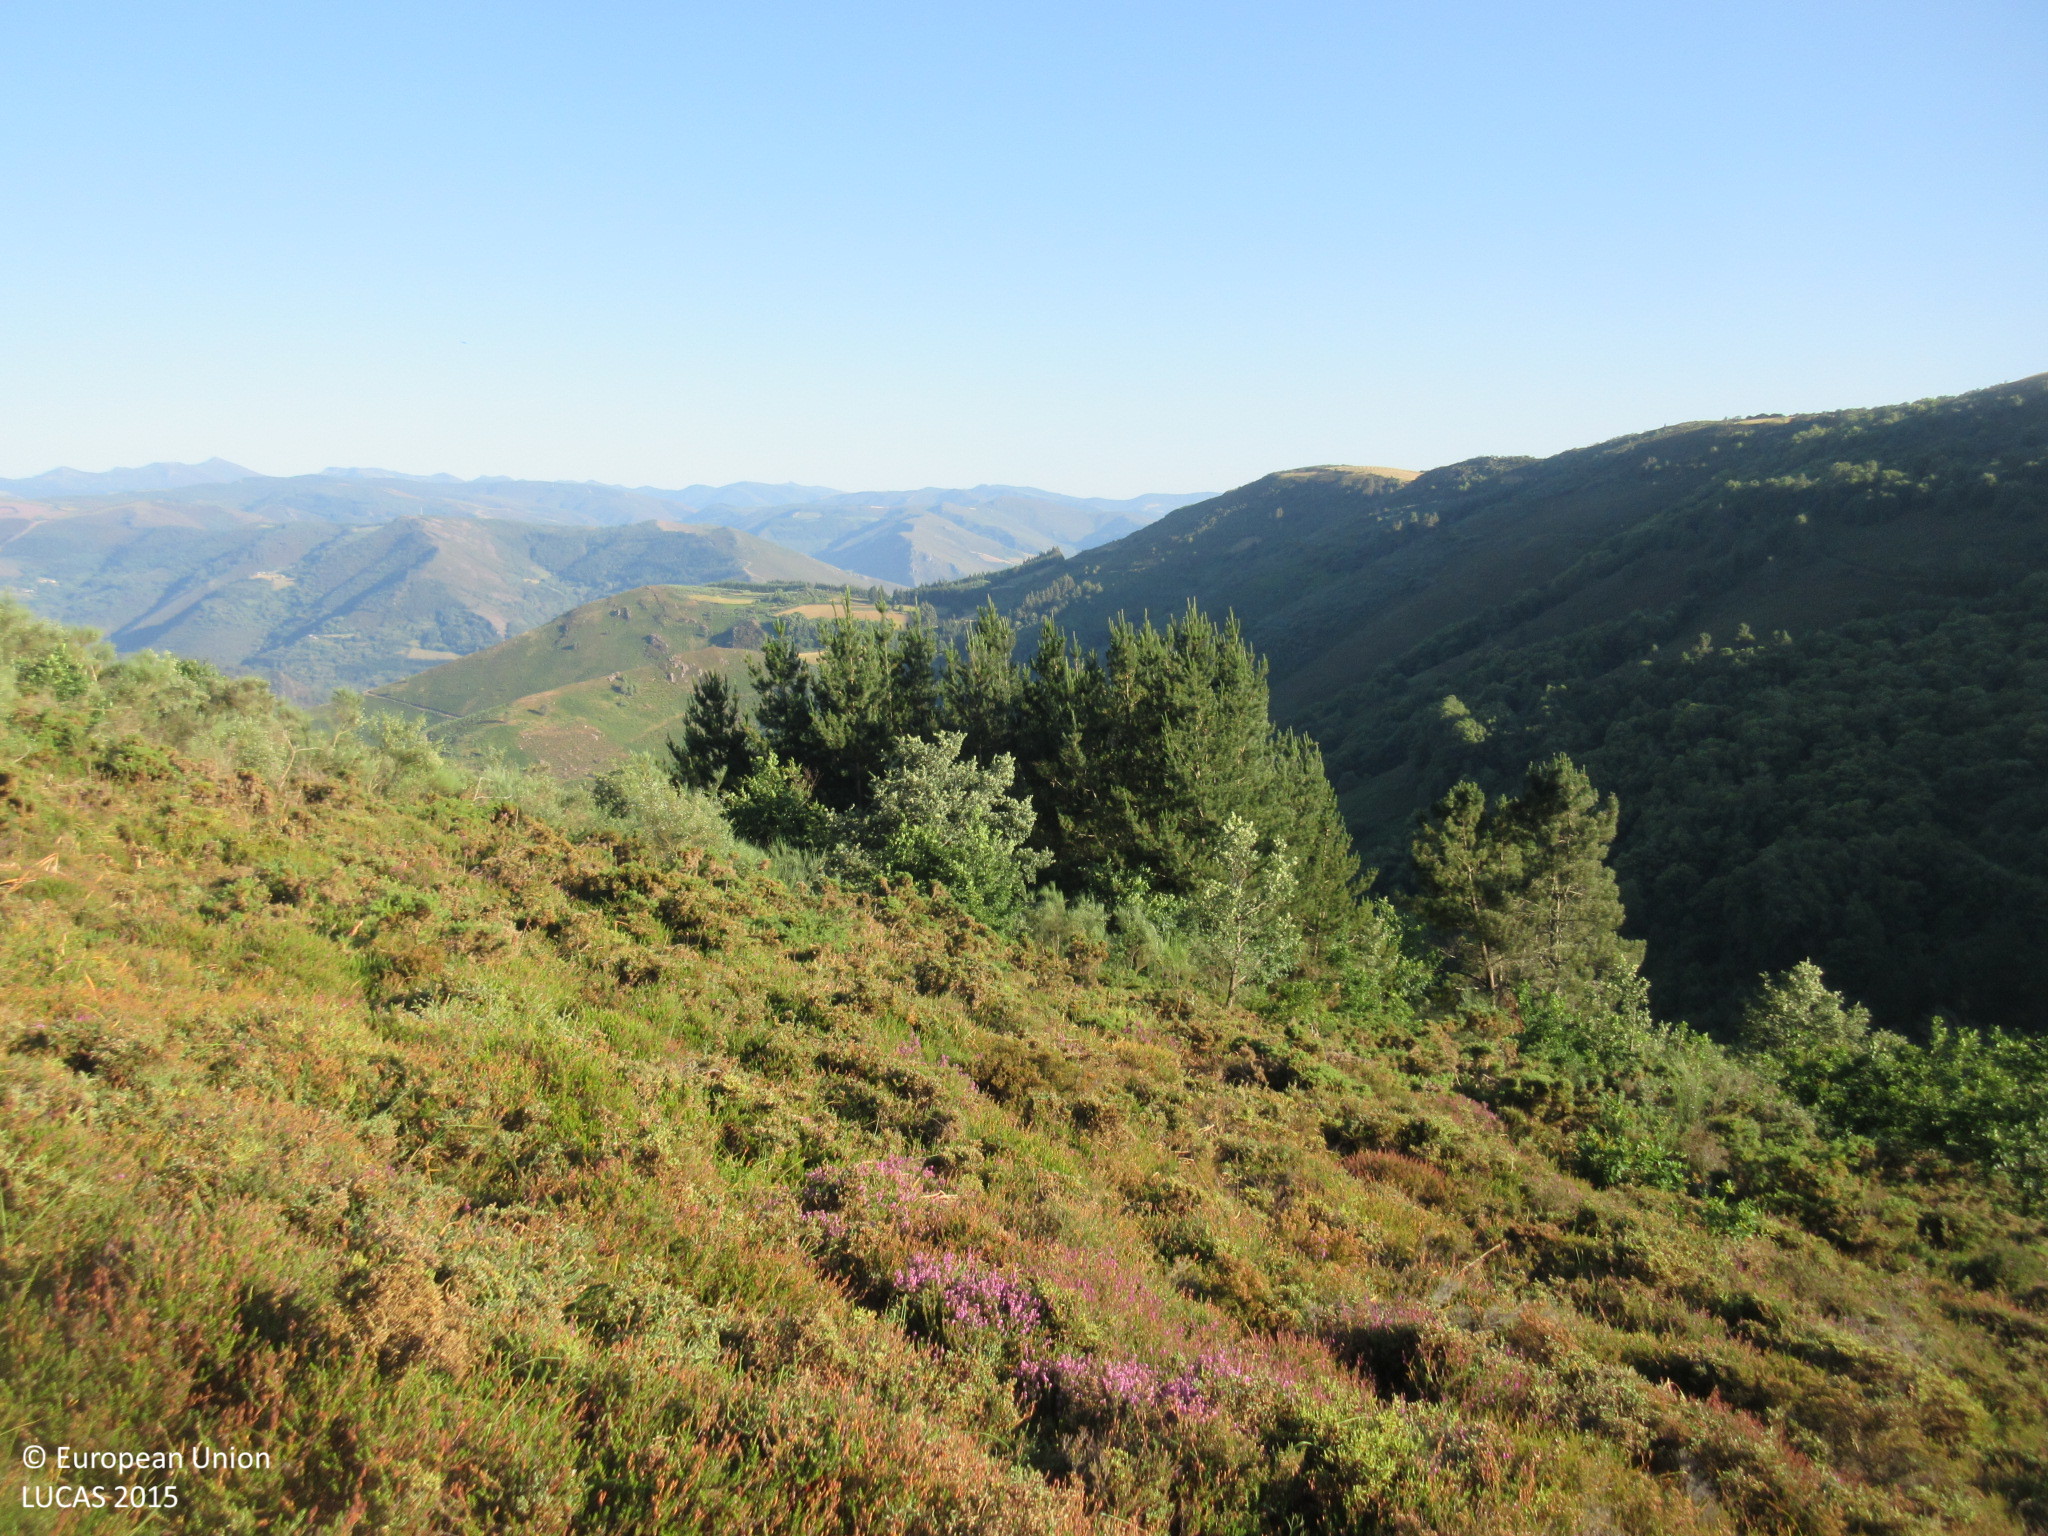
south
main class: Woodland
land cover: Broadleaved woodland
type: acidophilous oak and oak-birch forest
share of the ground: 50 - 75 %
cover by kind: broadleaved forest trees 70 %, shrubs 30 %
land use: Forestry
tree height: > 5 m
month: June
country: ES
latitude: 43.0121
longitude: -6.9809
